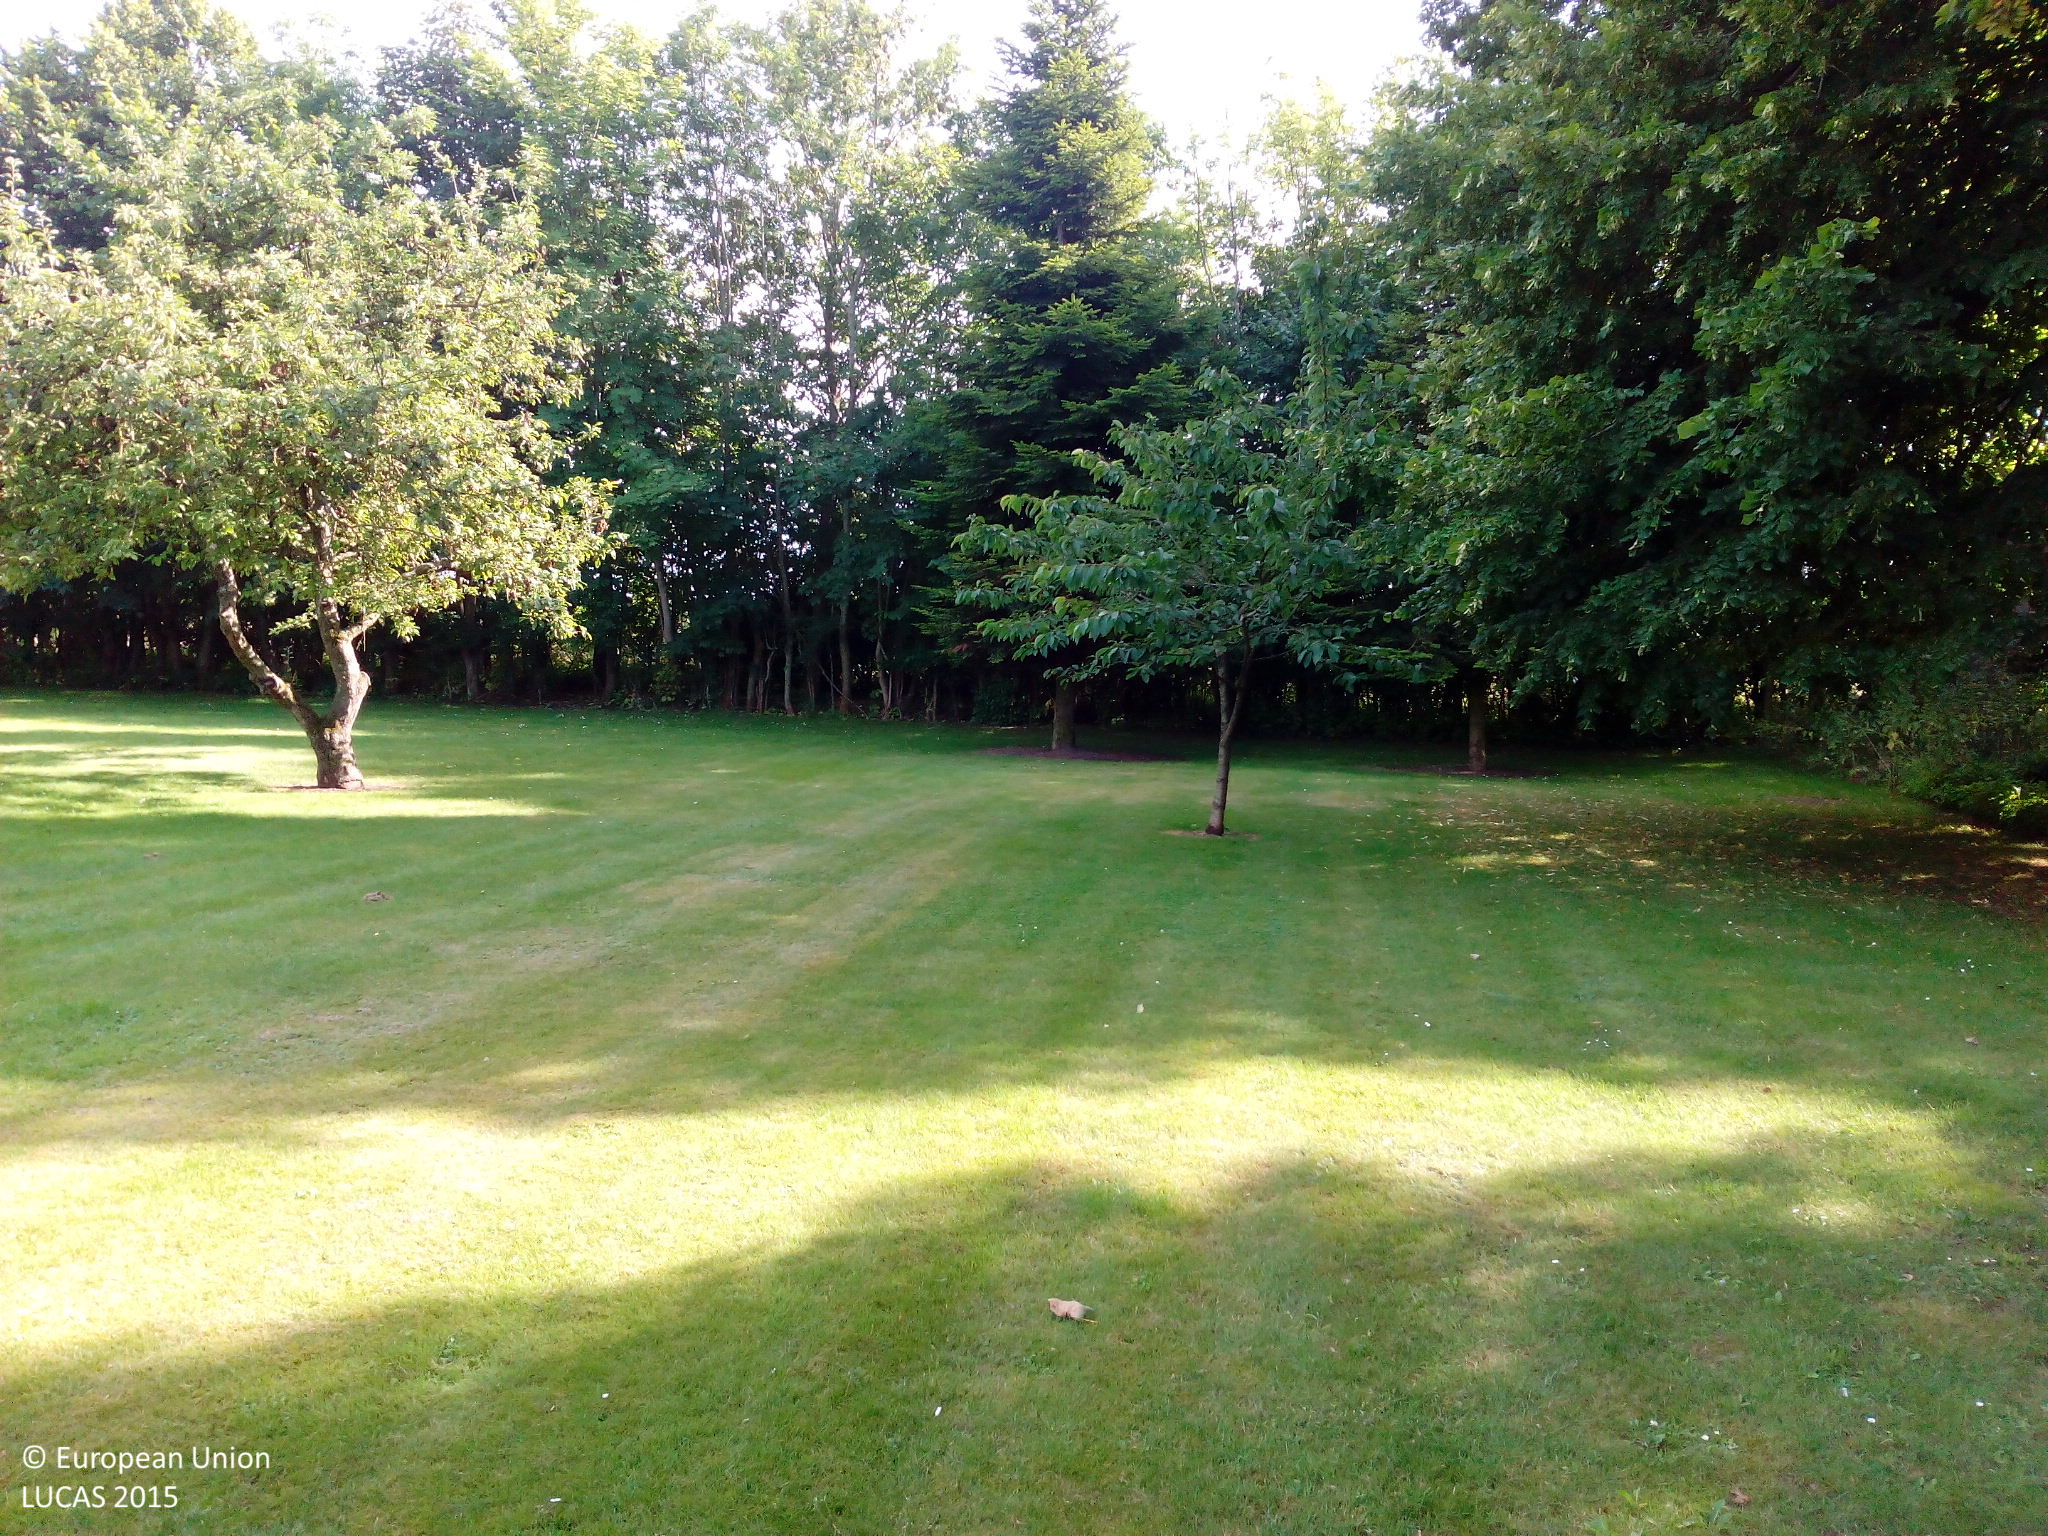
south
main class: Grassland
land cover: Grassland without tree/shrub cover
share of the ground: > 75 %
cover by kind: herbaceous plants 100 %
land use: Residential
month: August
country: DK
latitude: 55.6125
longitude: 12.1415
